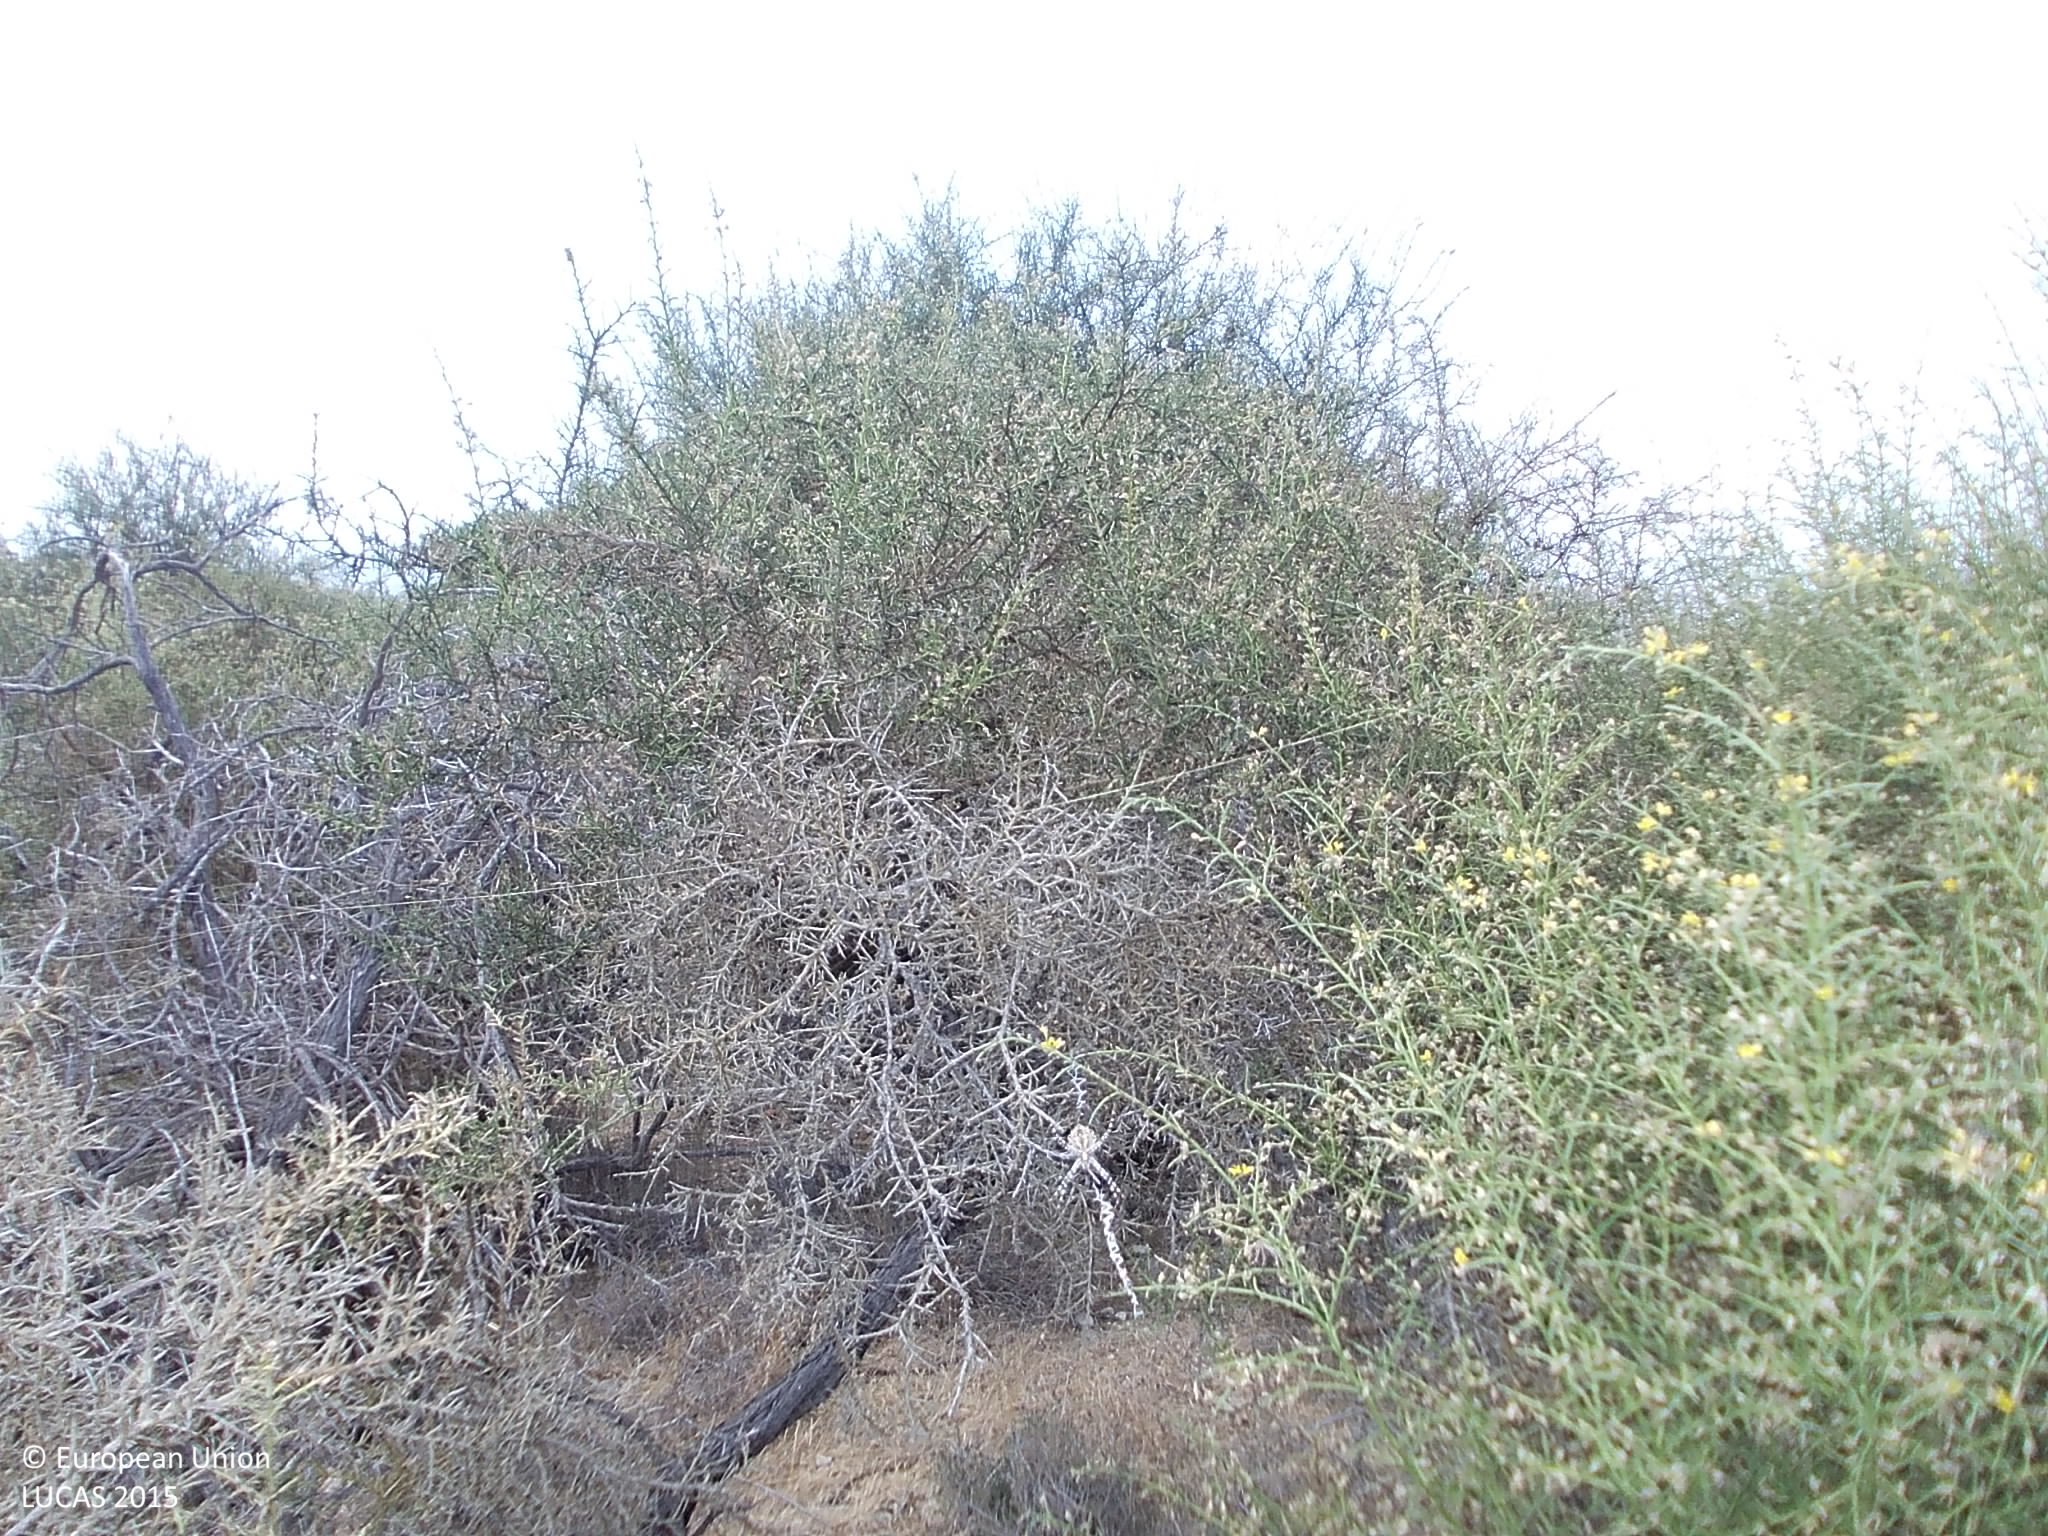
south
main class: Shrubland
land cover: Shrubland with sparse tree cover
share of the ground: > 75 %
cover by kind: shrubs 85 %, broadleaved forest trees 5 %, herbaceous plants 5 %, unconsolidated bare surface 5 %
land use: Semi-natural and natural areas not in use
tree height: < 5 m
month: August
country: CY
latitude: 34.7023
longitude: 32.6967
